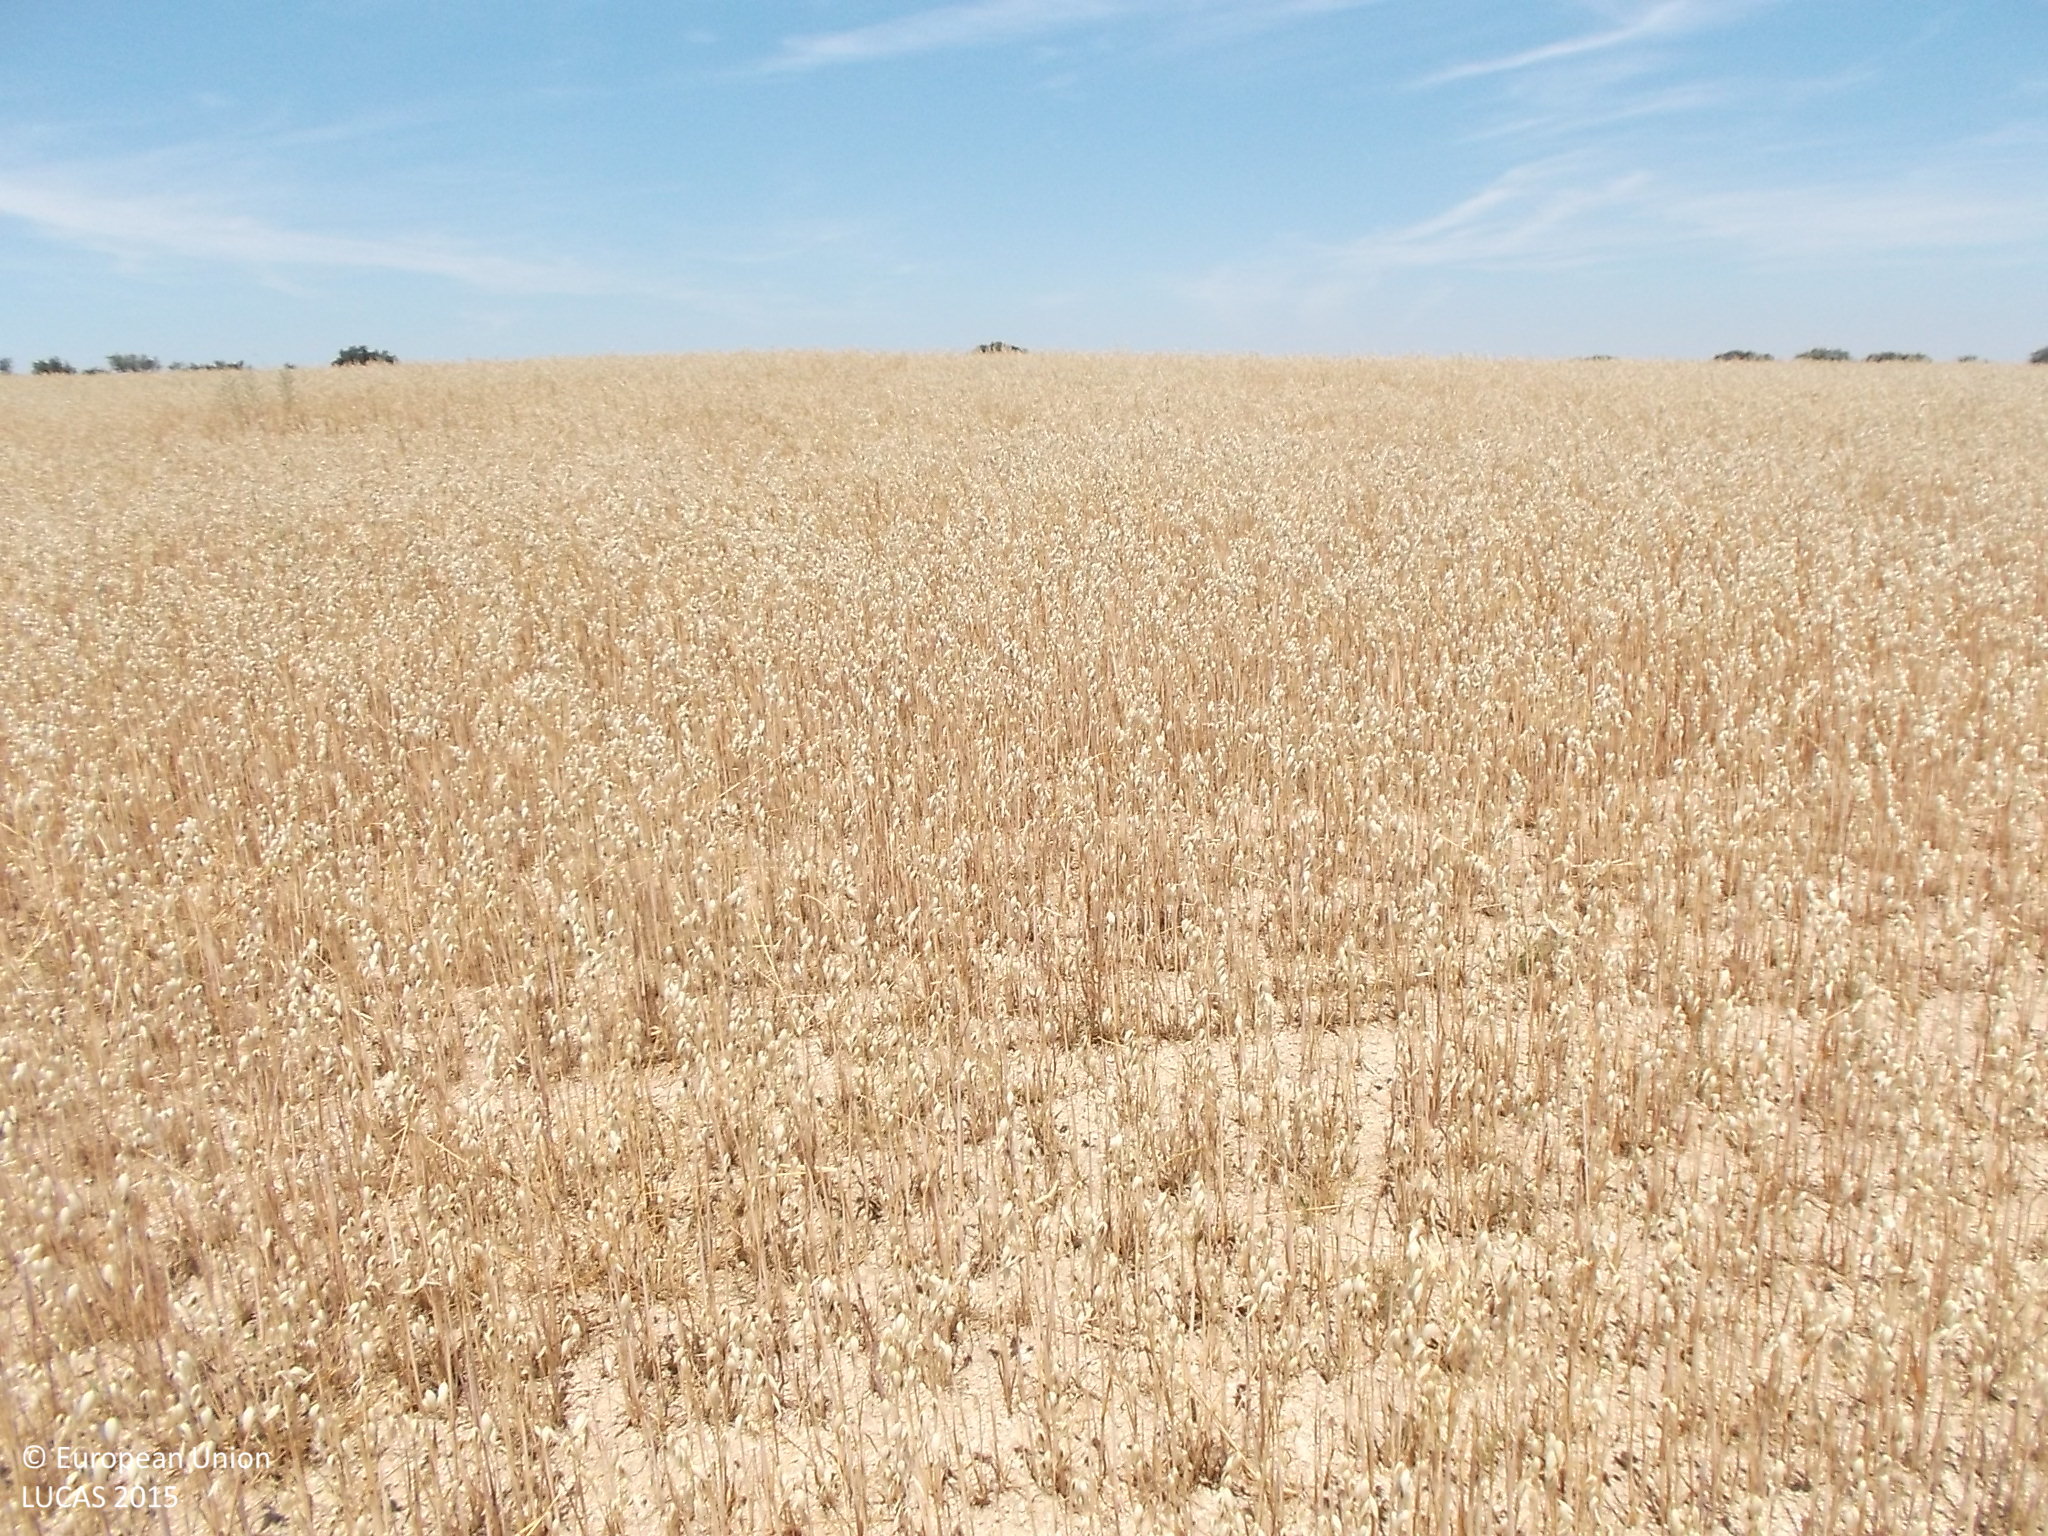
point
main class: Cropland
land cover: Oats
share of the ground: > 75 %
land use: Agriculture (excluding fallow land and kitchen gardens)
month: June
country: ES
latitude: 41.2900
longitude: -6.0550
